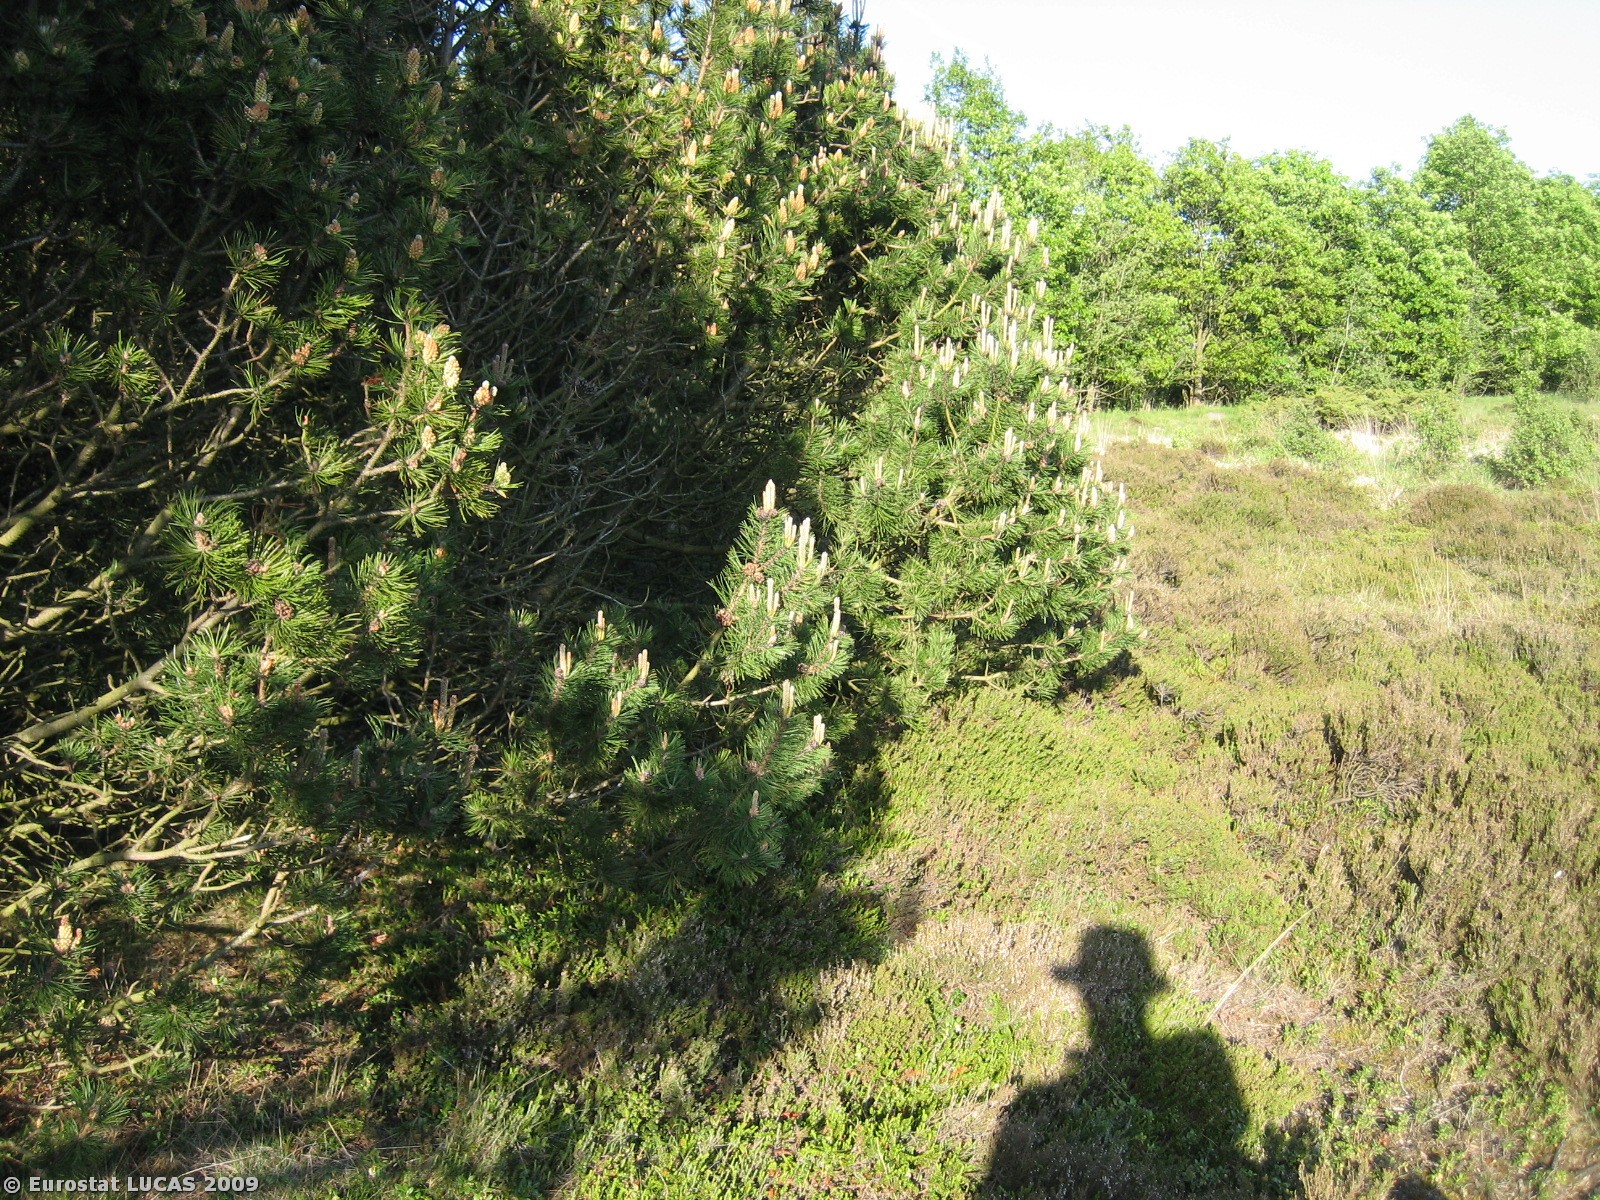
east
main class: Shrubland
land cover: Shrubland with sparse tree cover
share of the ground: > 75 %
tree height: > 5 m
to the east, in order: Shrubland with sparse tree cover; Broadleaved woodland; Coniferous woodland; Broadleaved woodland; Grassland without tree/shrub cover; Broadleaved woodland; Rye
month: May
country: DK
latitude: 55.9696
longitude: 9.2158
